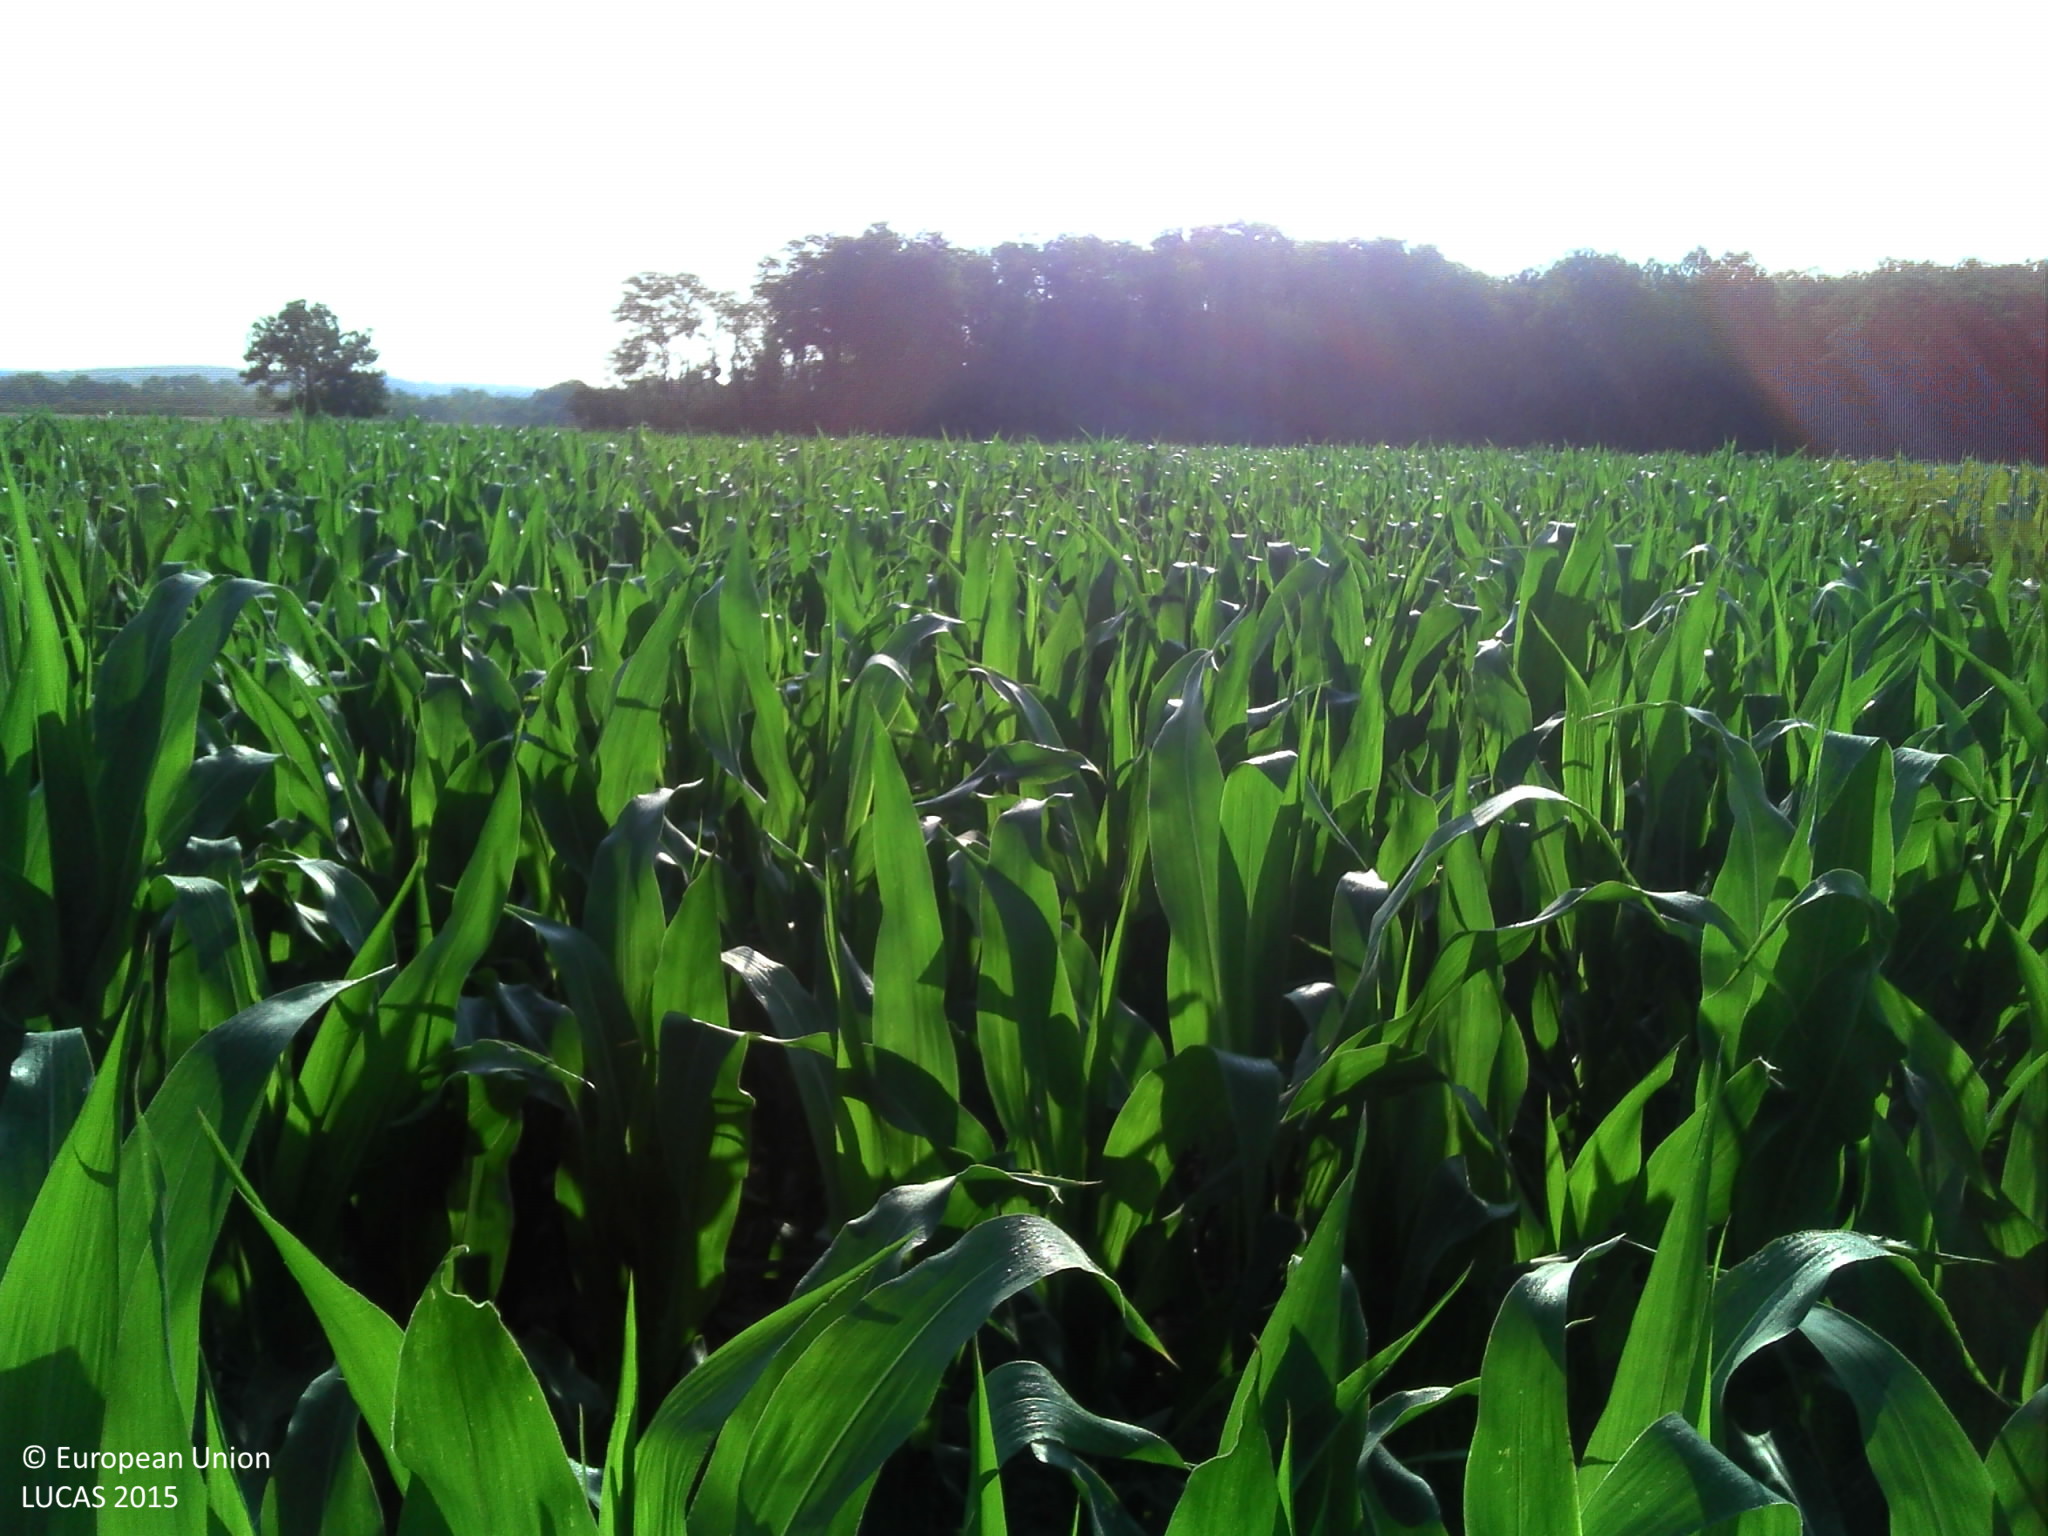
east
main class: Cropland
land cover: Maize
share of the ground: > 75 %
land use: Agriculture (excluding fallow land and kitchen gardens)
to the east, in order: Maize; Fences; Broadleaved woodland; Ditches and canals; Tracks; Broadleaved woodland
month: July
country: FR
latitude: 46.8976
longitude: 3.2632
